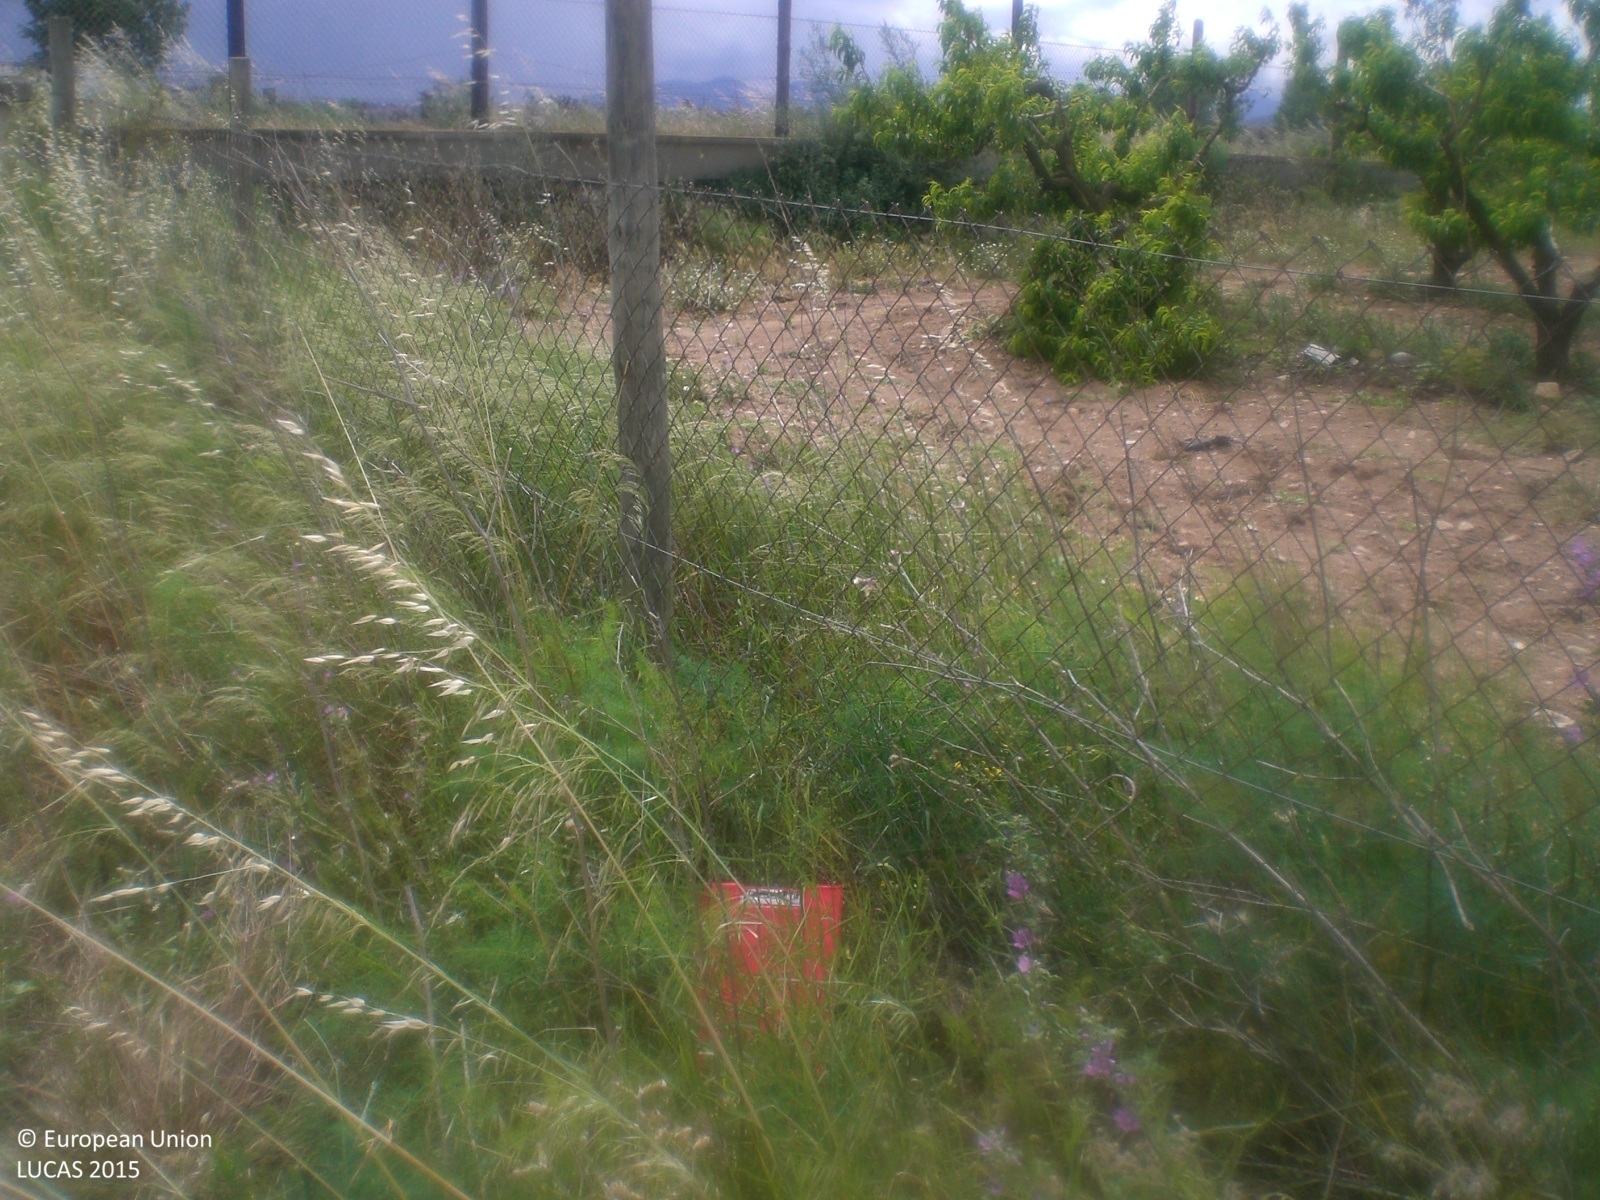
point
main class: Cropland
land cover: Other fruit trees and berries
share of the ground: 25 - 50 %
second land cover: Spontaneously vegetated surfaces
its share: 50 - 75 %
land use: Agriculture (excluding fallow land and kitchen gardens)
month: May
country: ES
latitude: 42.3186
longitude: 2.9644
